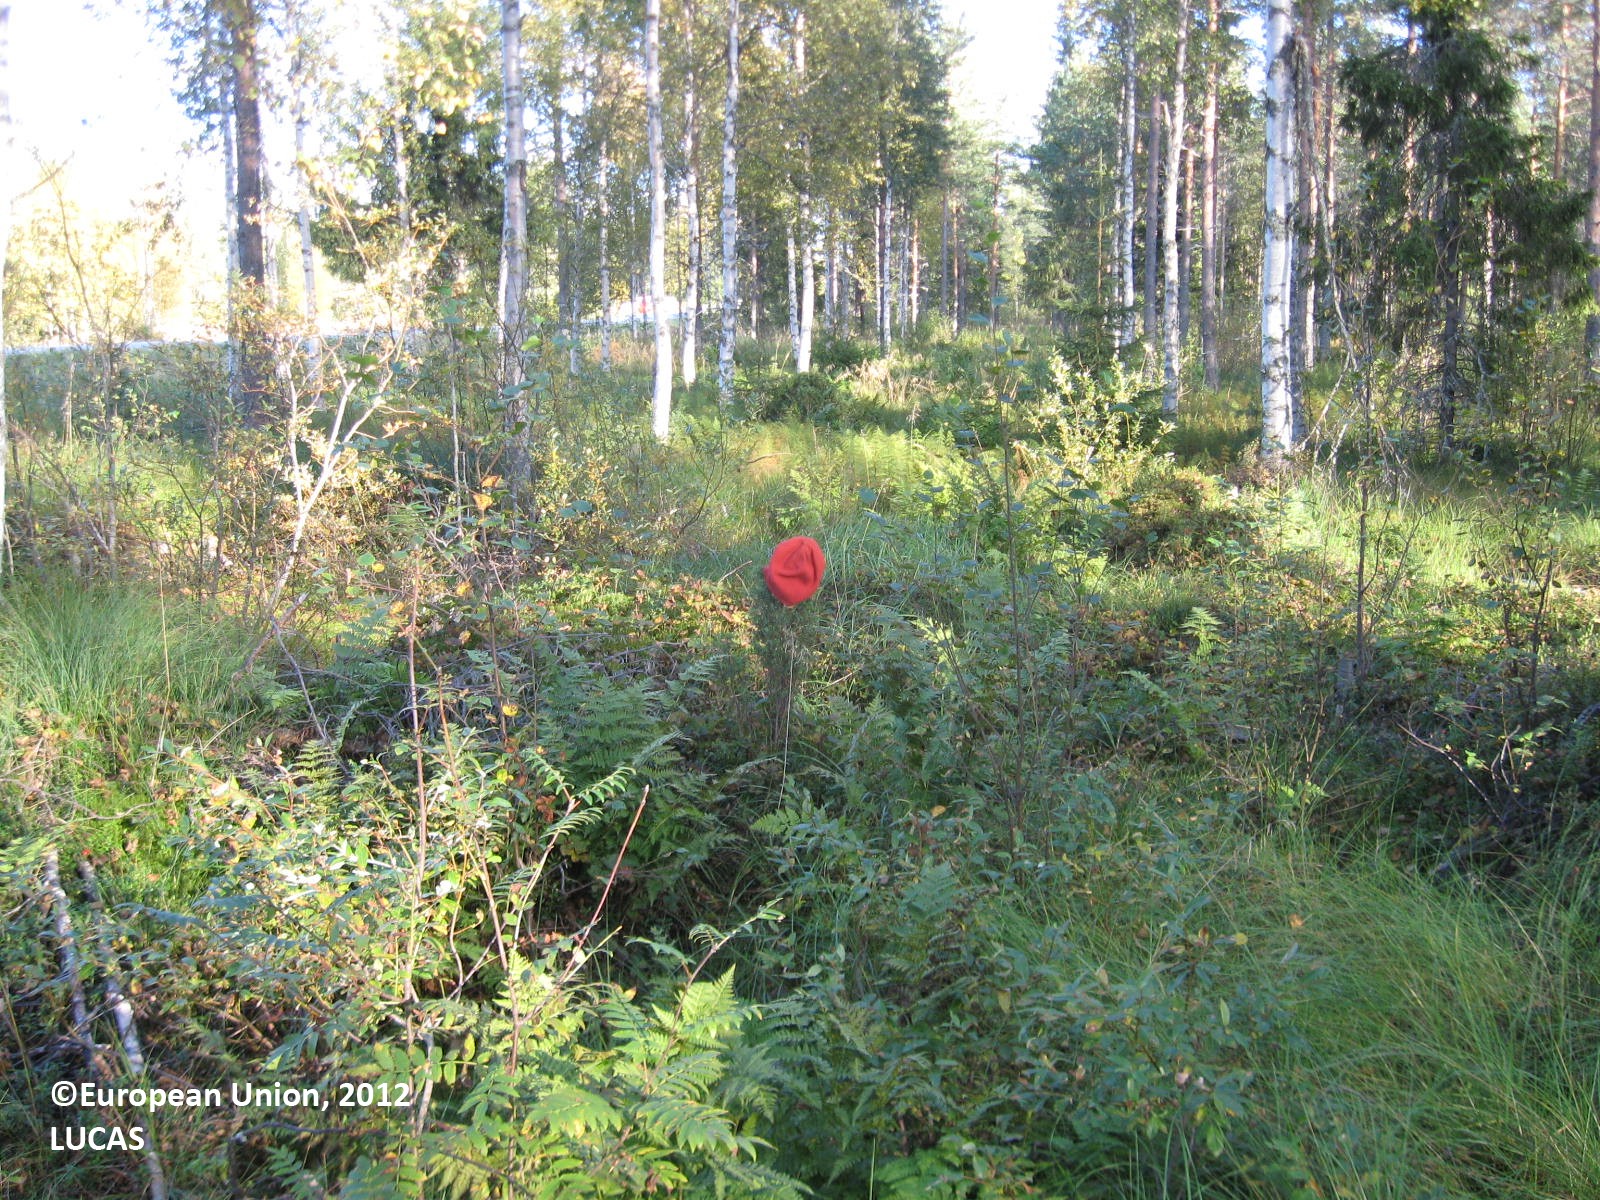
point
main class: Woodland
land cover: Other mixed woodland
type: boreal forest
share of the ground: > 75 %
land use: Forestry
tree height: > 5 m
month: August
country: FI
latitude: 63.9728
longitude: 29.6521
